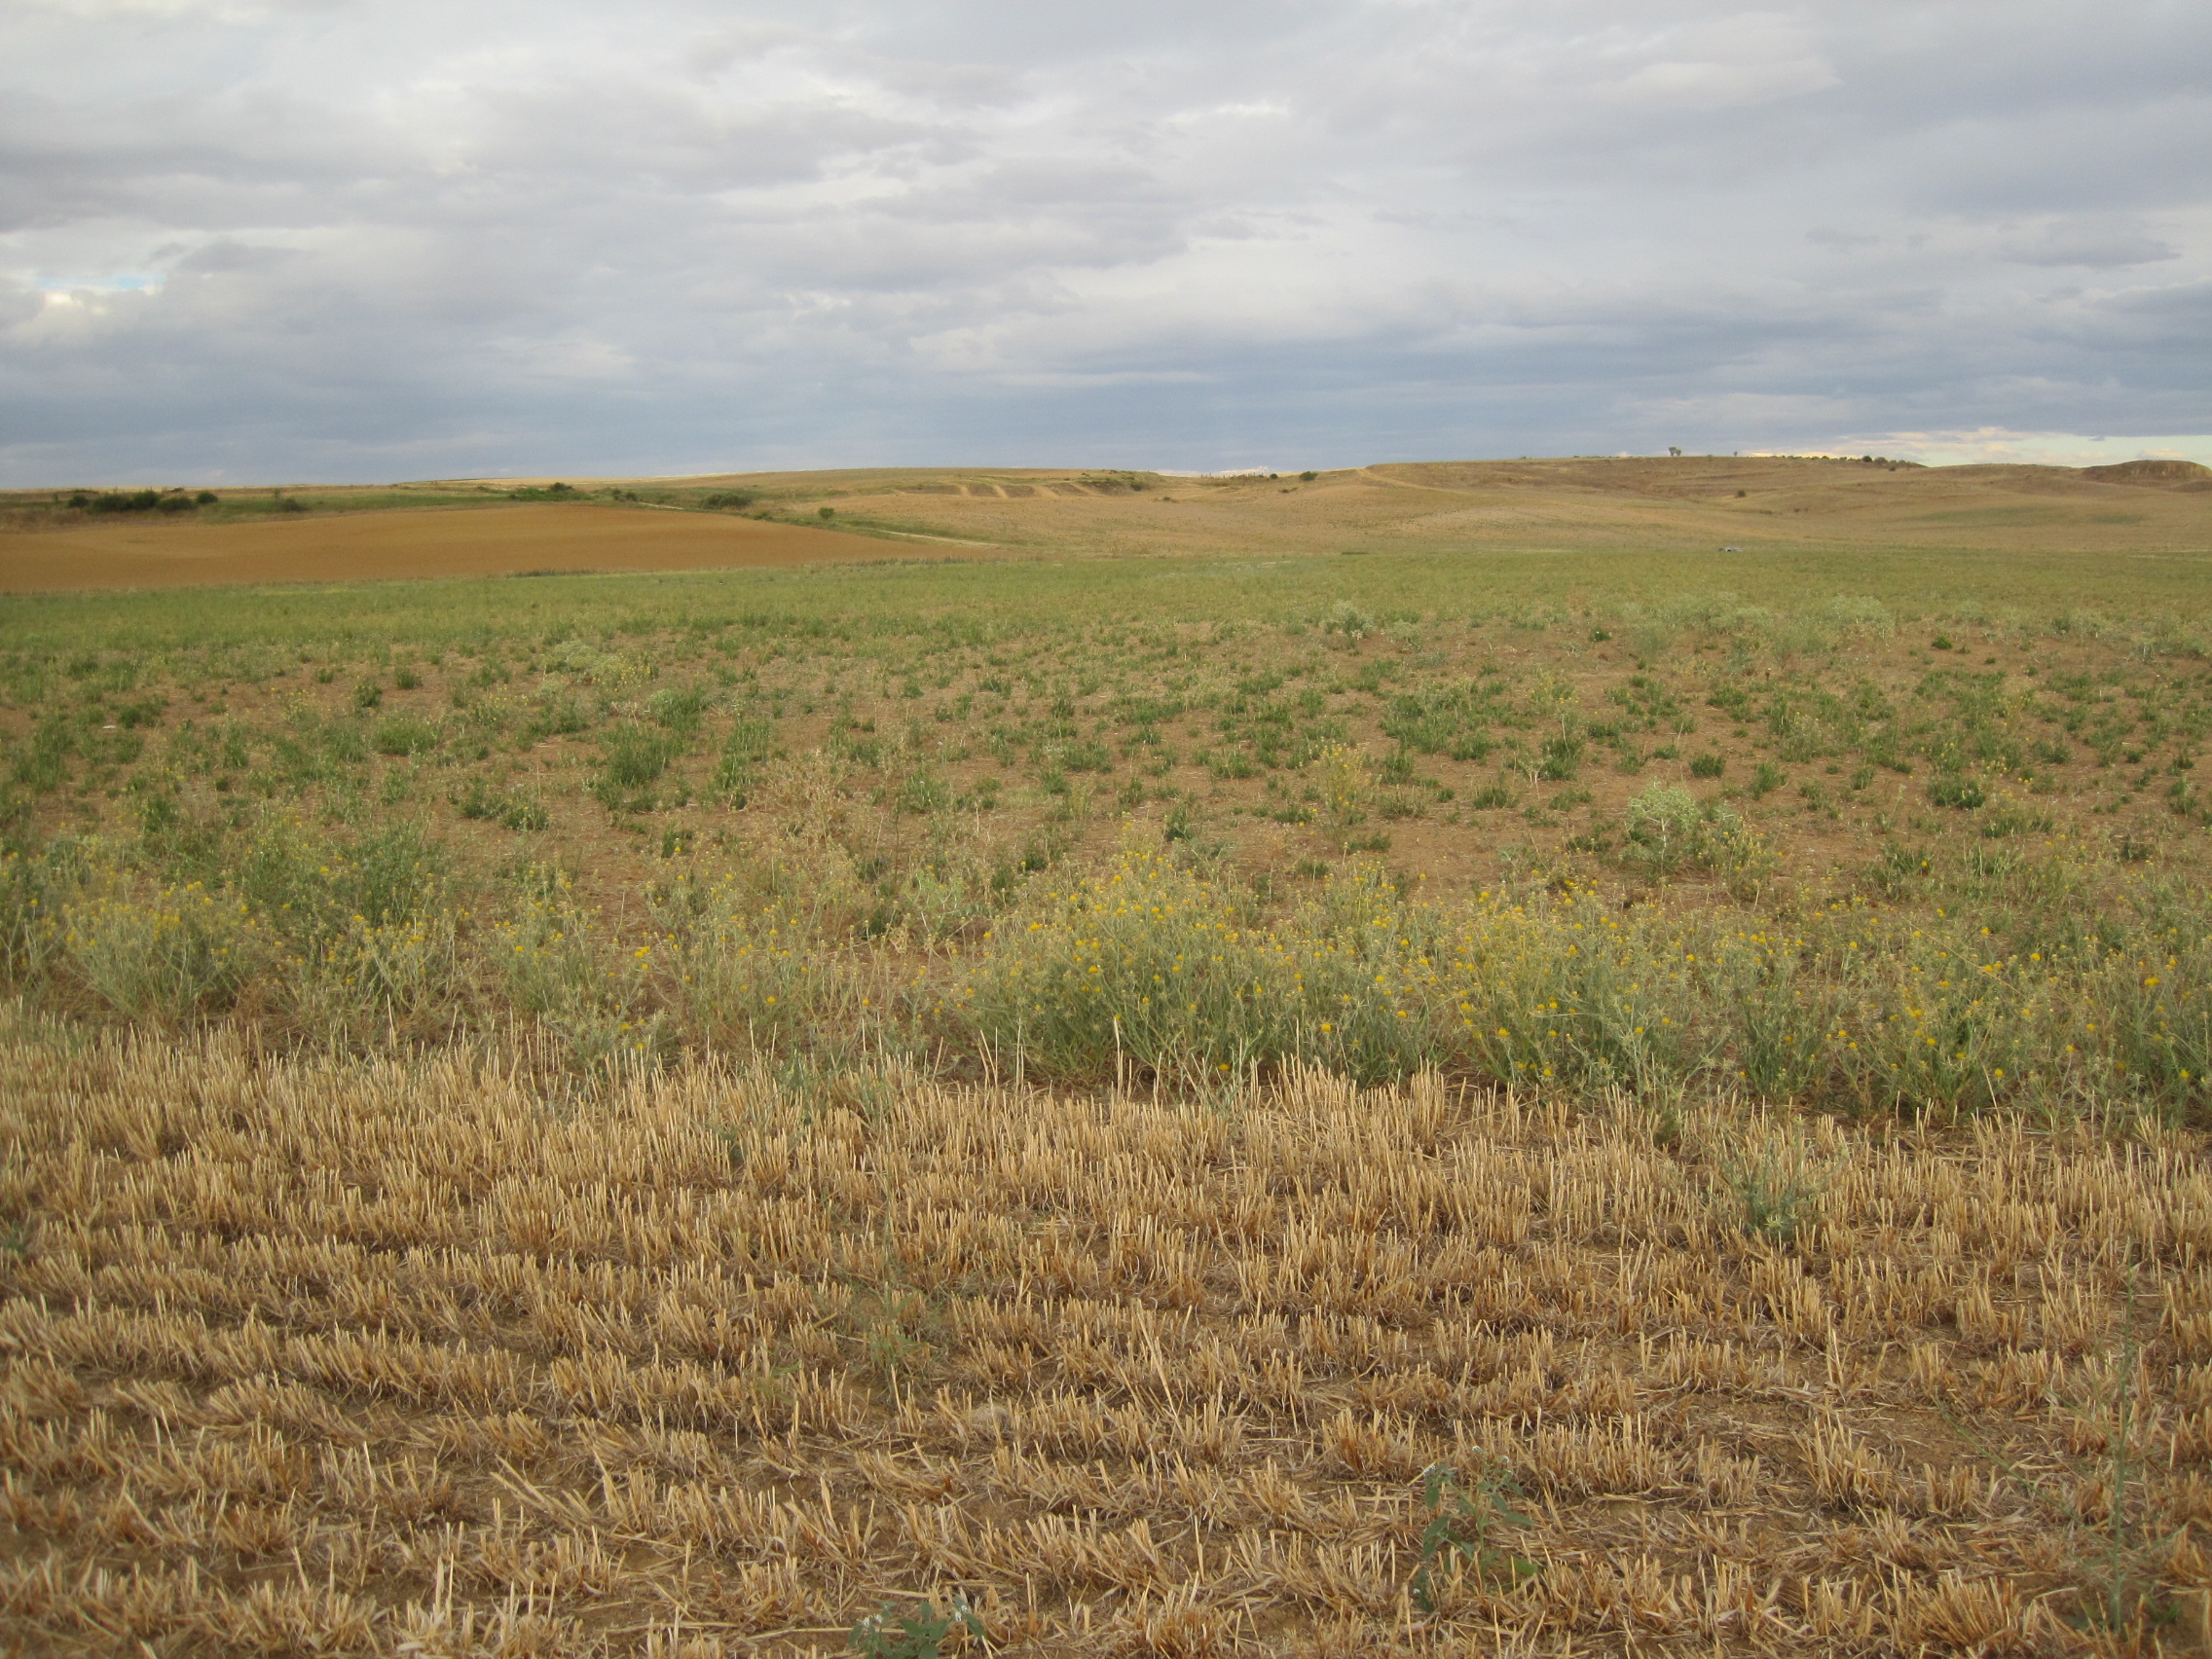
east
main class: Cropland
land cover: Barley
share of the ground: < 10 %
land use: Agriculture (excluding fallow land and kitchen gardens)
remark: Harvested field
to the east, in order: Barley; Grass margins; Lucerne
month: July
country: ES
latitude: 41.9251
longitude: -5.4119
